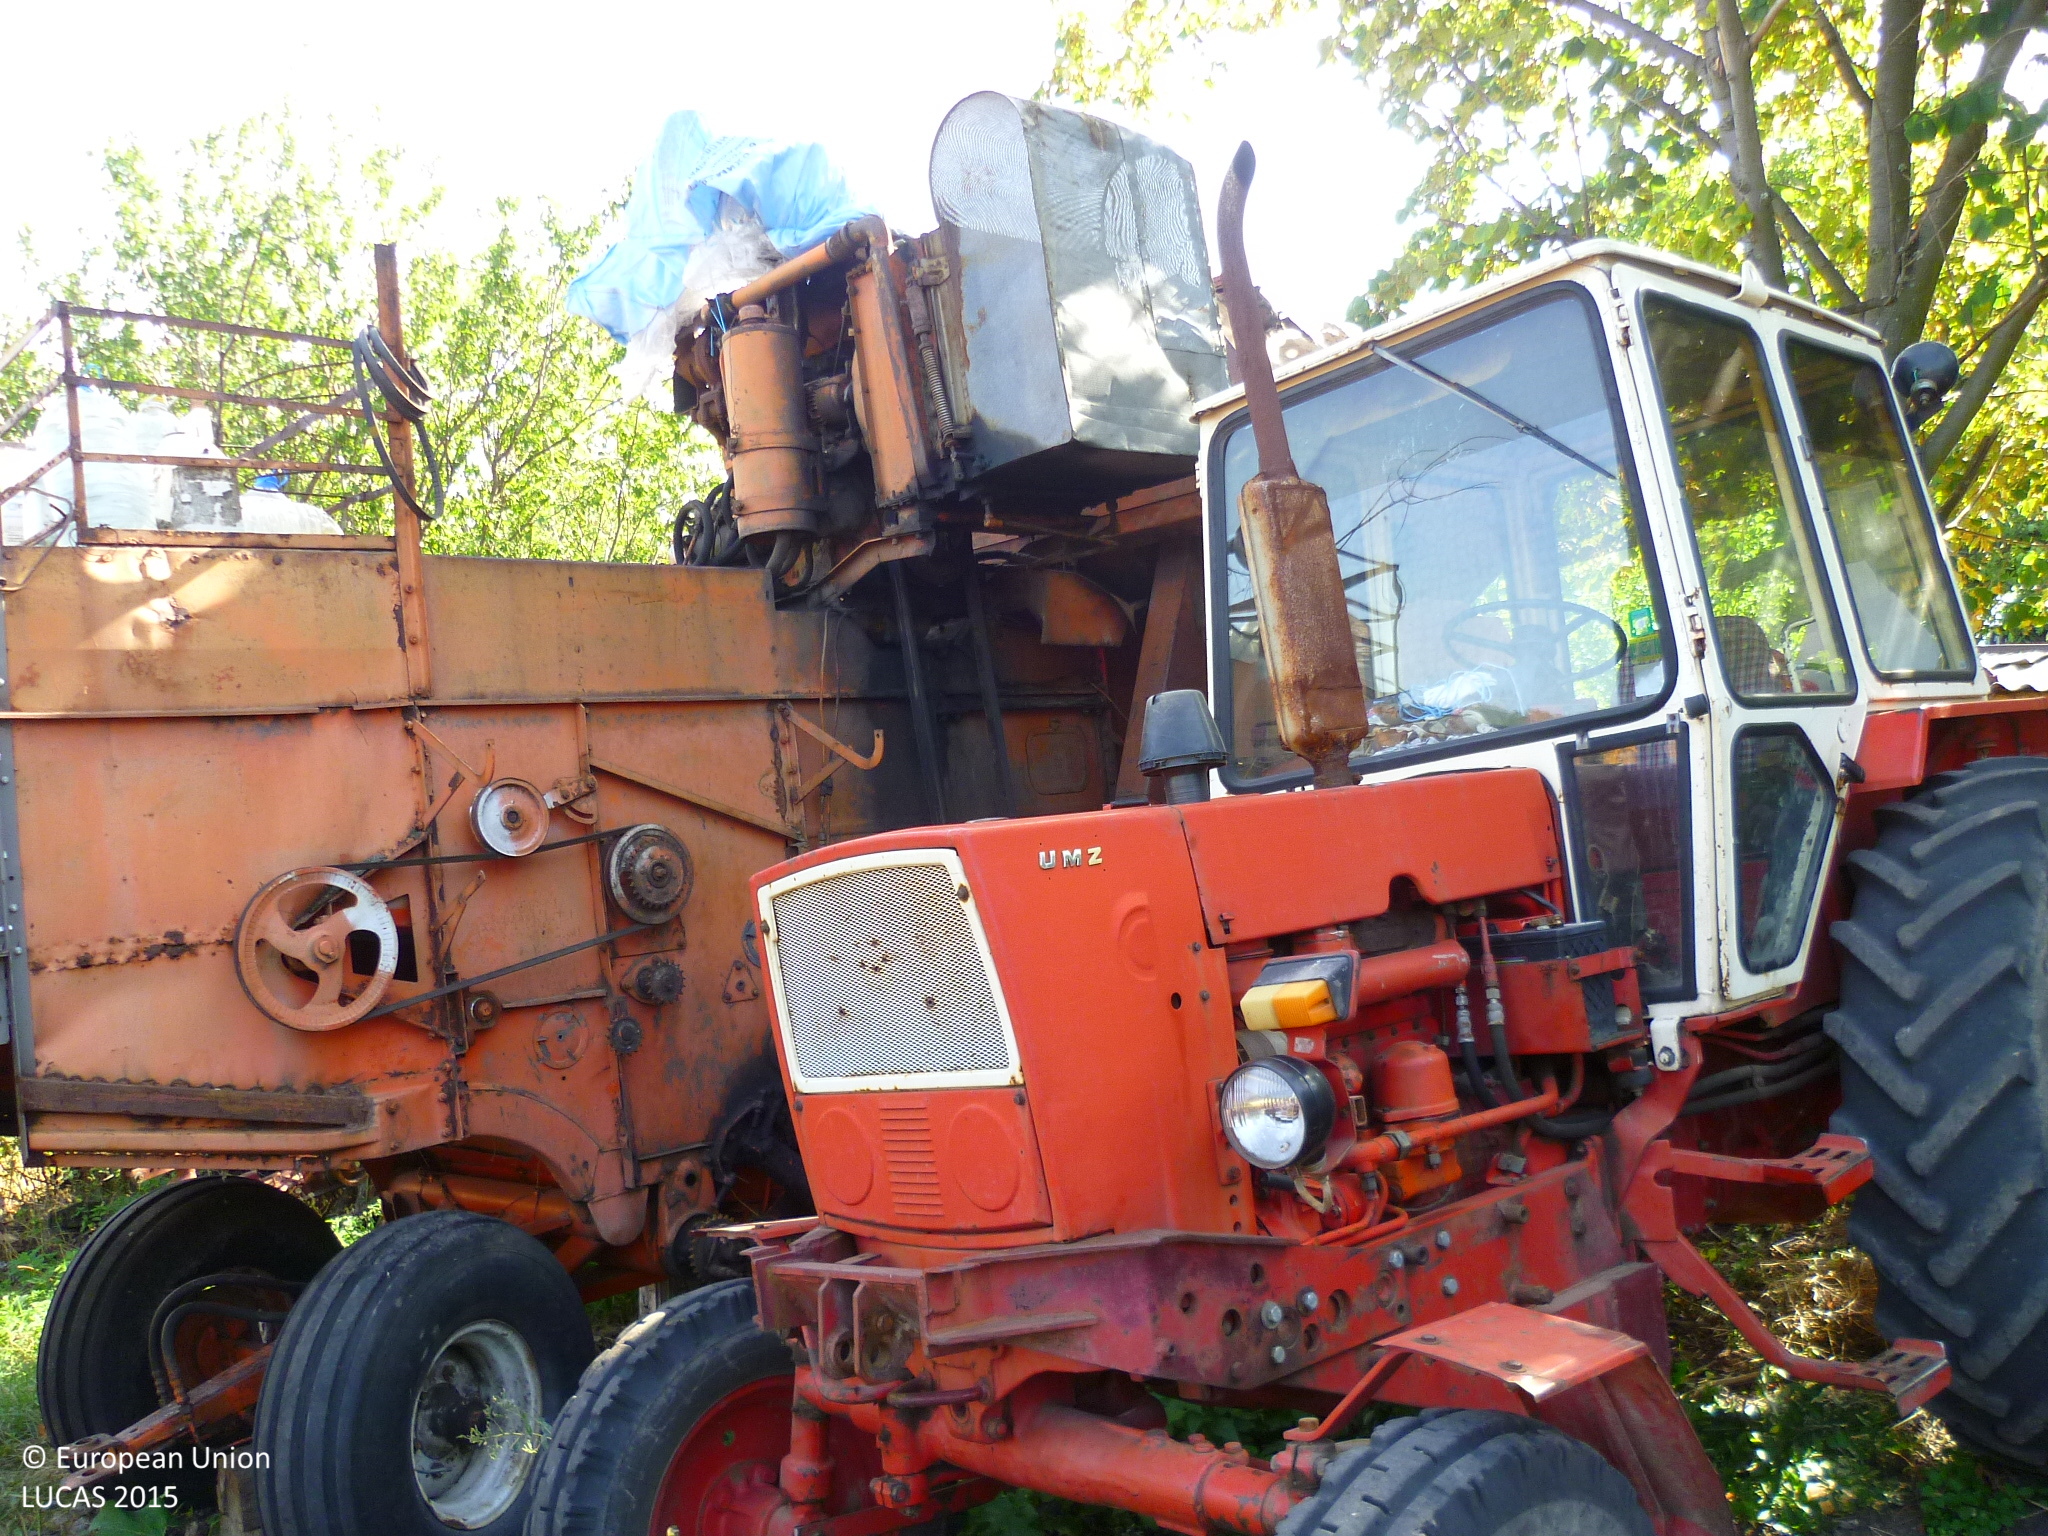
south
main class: Grassland
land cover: Grassland with sparse tree/shrub cover
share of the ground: 50 - 75 %
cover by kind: herbaceous plants 60 %, unconsolidated bare surface 30 %, broadleaved forest trees 5 %, shrubs 5 %
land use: Residential
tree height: > 5 m
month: September
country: BG
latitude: 42.6646
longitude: 23.0481
